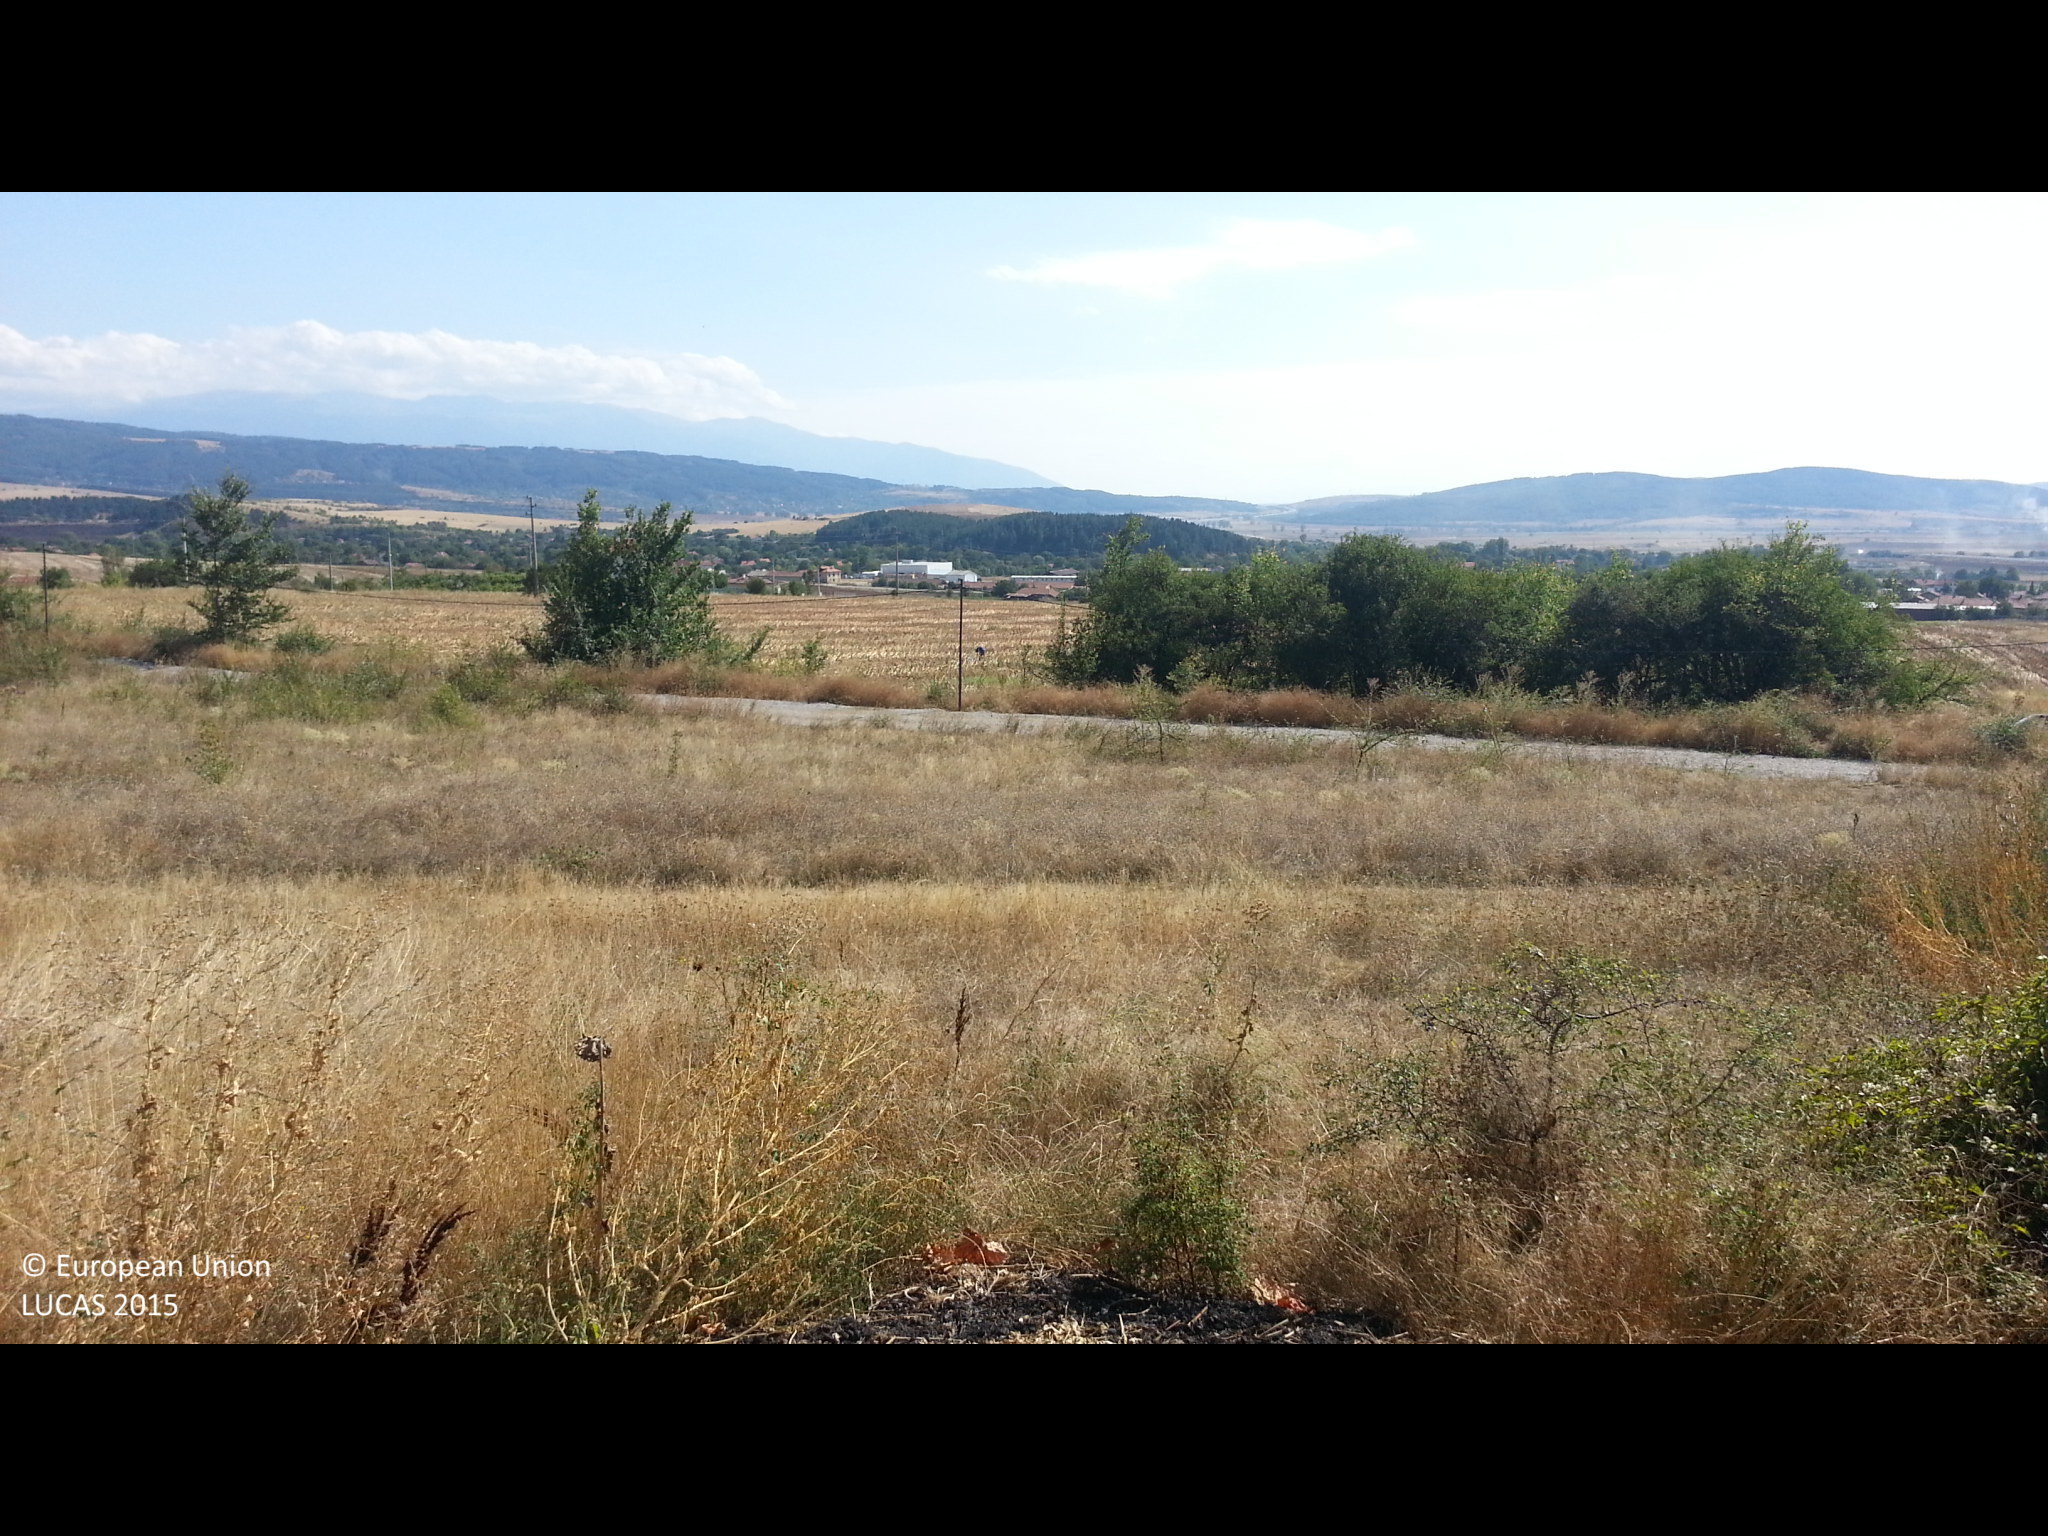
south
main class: Cropland
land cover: Apple fruit
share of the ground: 50 - 75 %
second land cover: Spontaneously vegetated surfaces
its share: > 75 %
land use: Kitchen garden
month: September
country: BG
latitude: 42.4536
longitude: 23.1249
